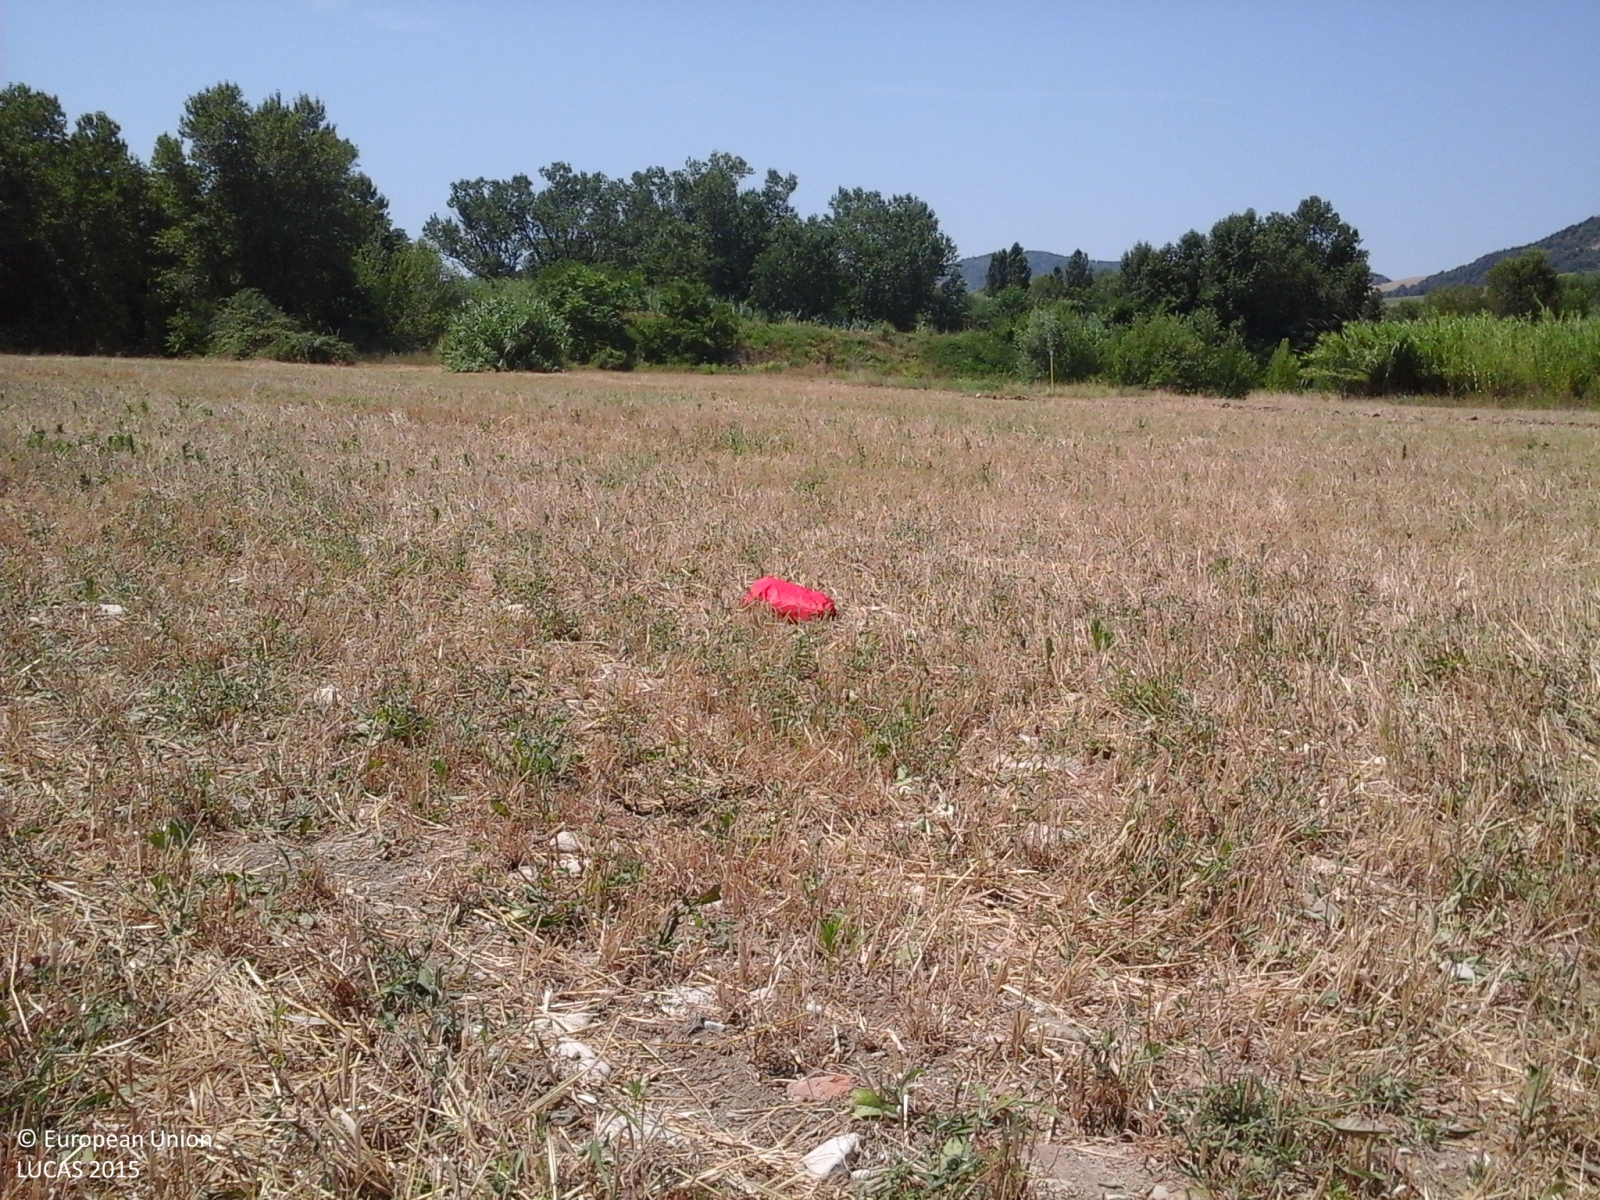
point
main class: Cropland
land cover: Barley
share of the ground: > 75 %
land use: Agriculture (excluding fallow land and kitchen gardens)
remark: Harvested field
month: July
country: IT
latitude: 43.9619
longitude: 12.3997
